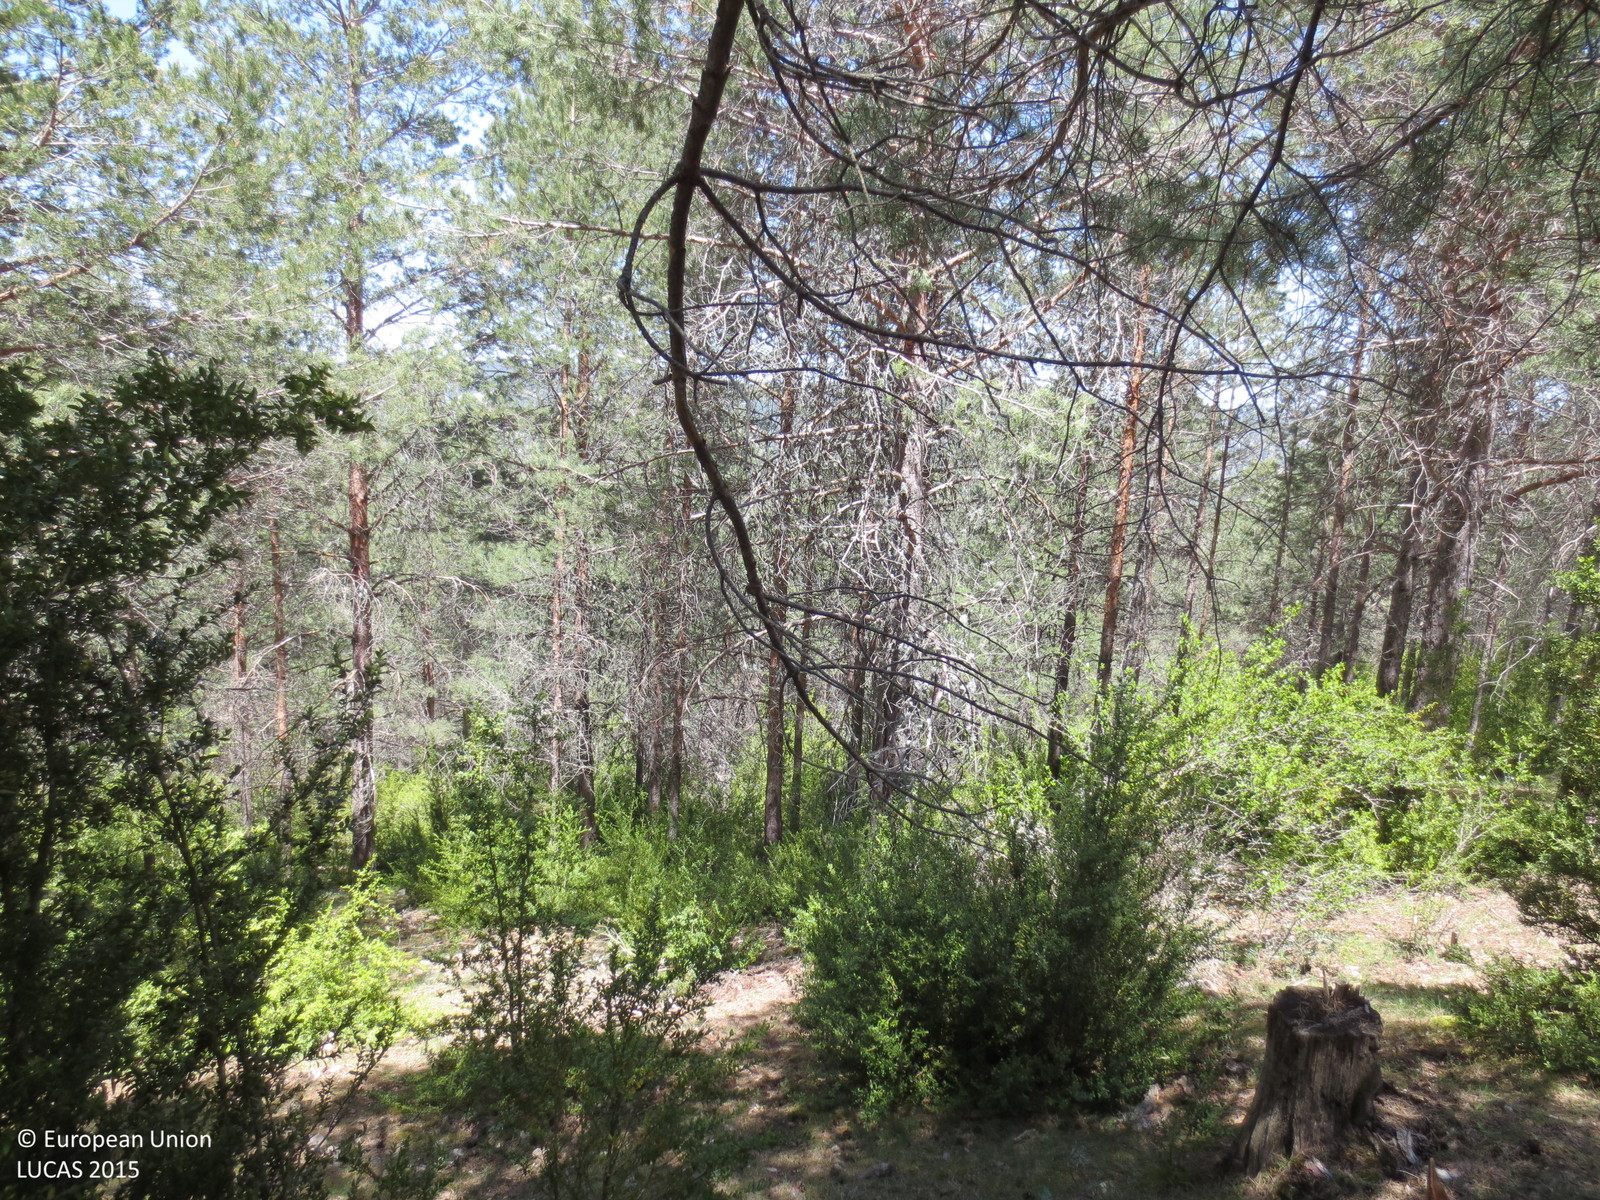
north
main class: Woodland
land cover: Pine dominated coniferous woodland
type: coniferous forest of the mediterranean region
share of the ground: 50 - 75 %
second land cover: Shrubland without tree cover
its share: 25 - 50 %
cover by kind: coniferous forest trees 60 %, shrubs 30 %, herbaceous plants 10 %
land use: Forestry
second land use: Agriculture (excluding fallow land and kitchen gardens)
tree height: > 5 m
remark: Clear cut
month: May
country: ES
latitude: 40.3717
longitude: -1.9718
